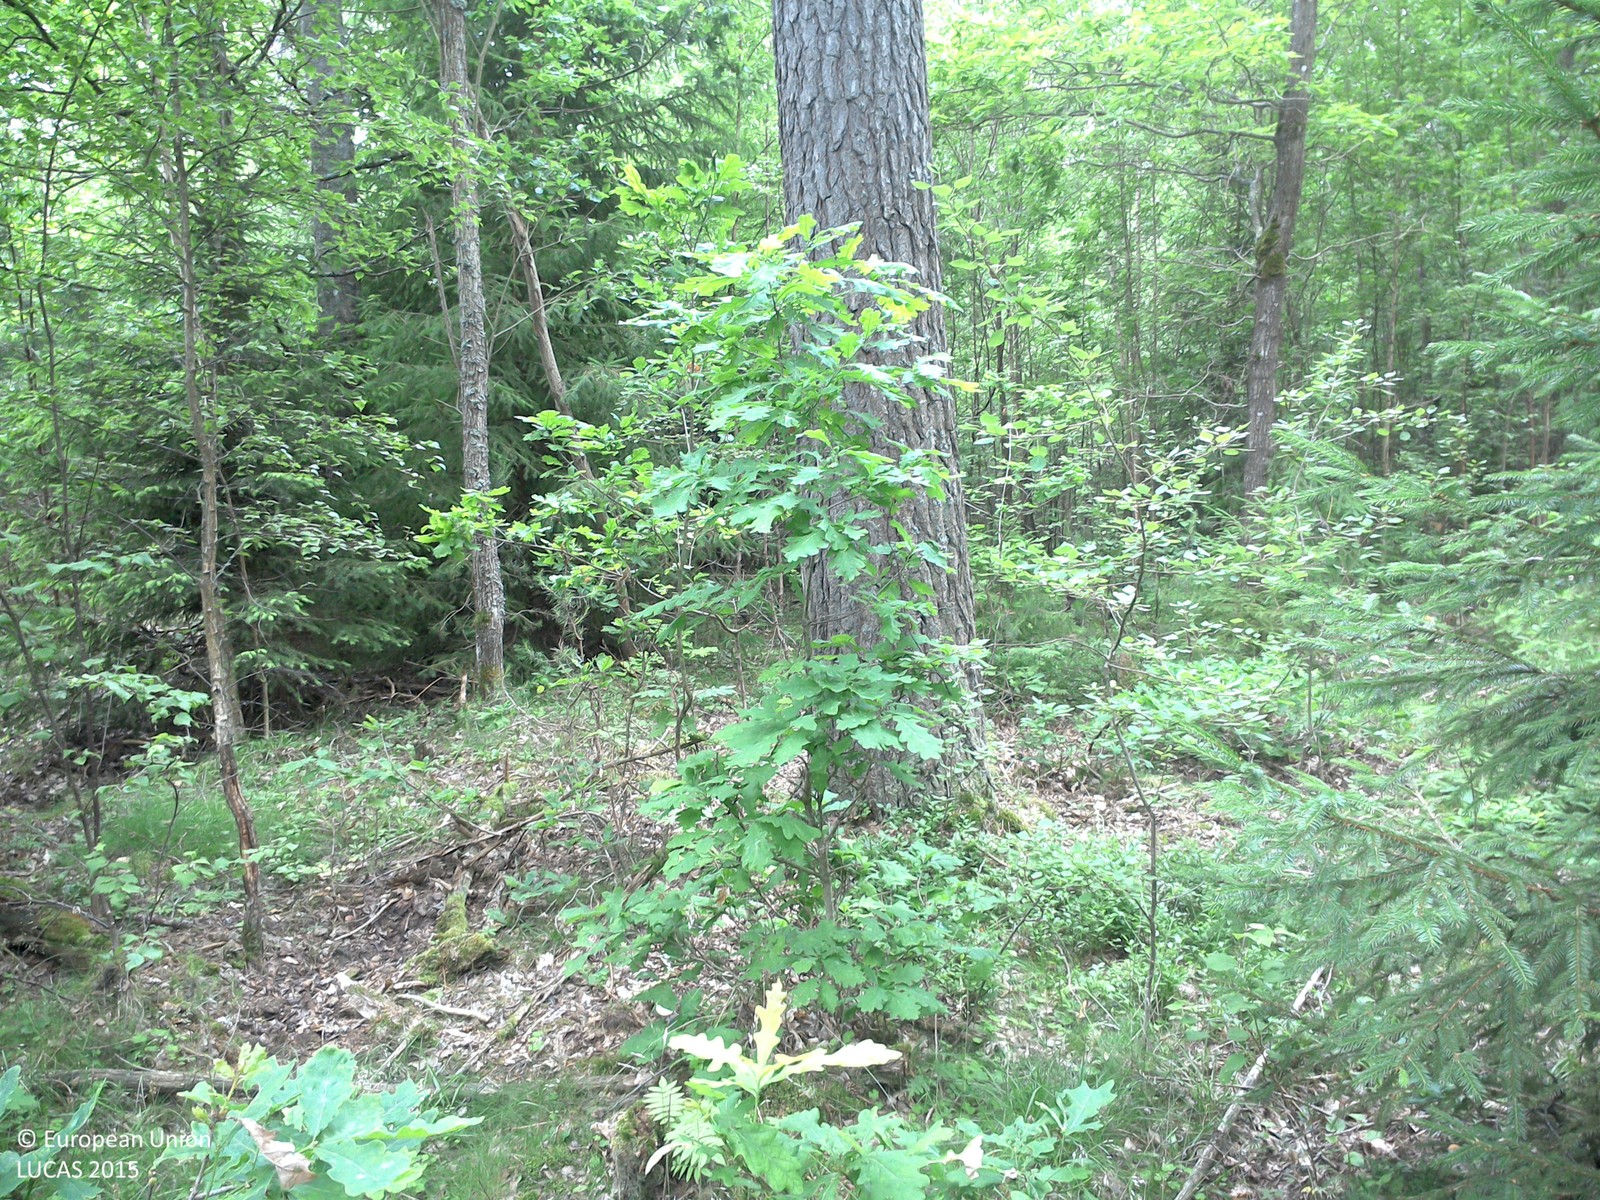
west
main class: Woodland
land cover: Pine dominated mixed woodland
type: boreal forest
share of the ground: 50 - 75 %
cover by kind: coniferous forest trees 55 %, herbaceous plants 25 %, broadleaved forest trees 20 %
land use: Forestry
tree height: > 5 m
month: June
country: SE
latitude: 58.4140
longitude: 15.4891
